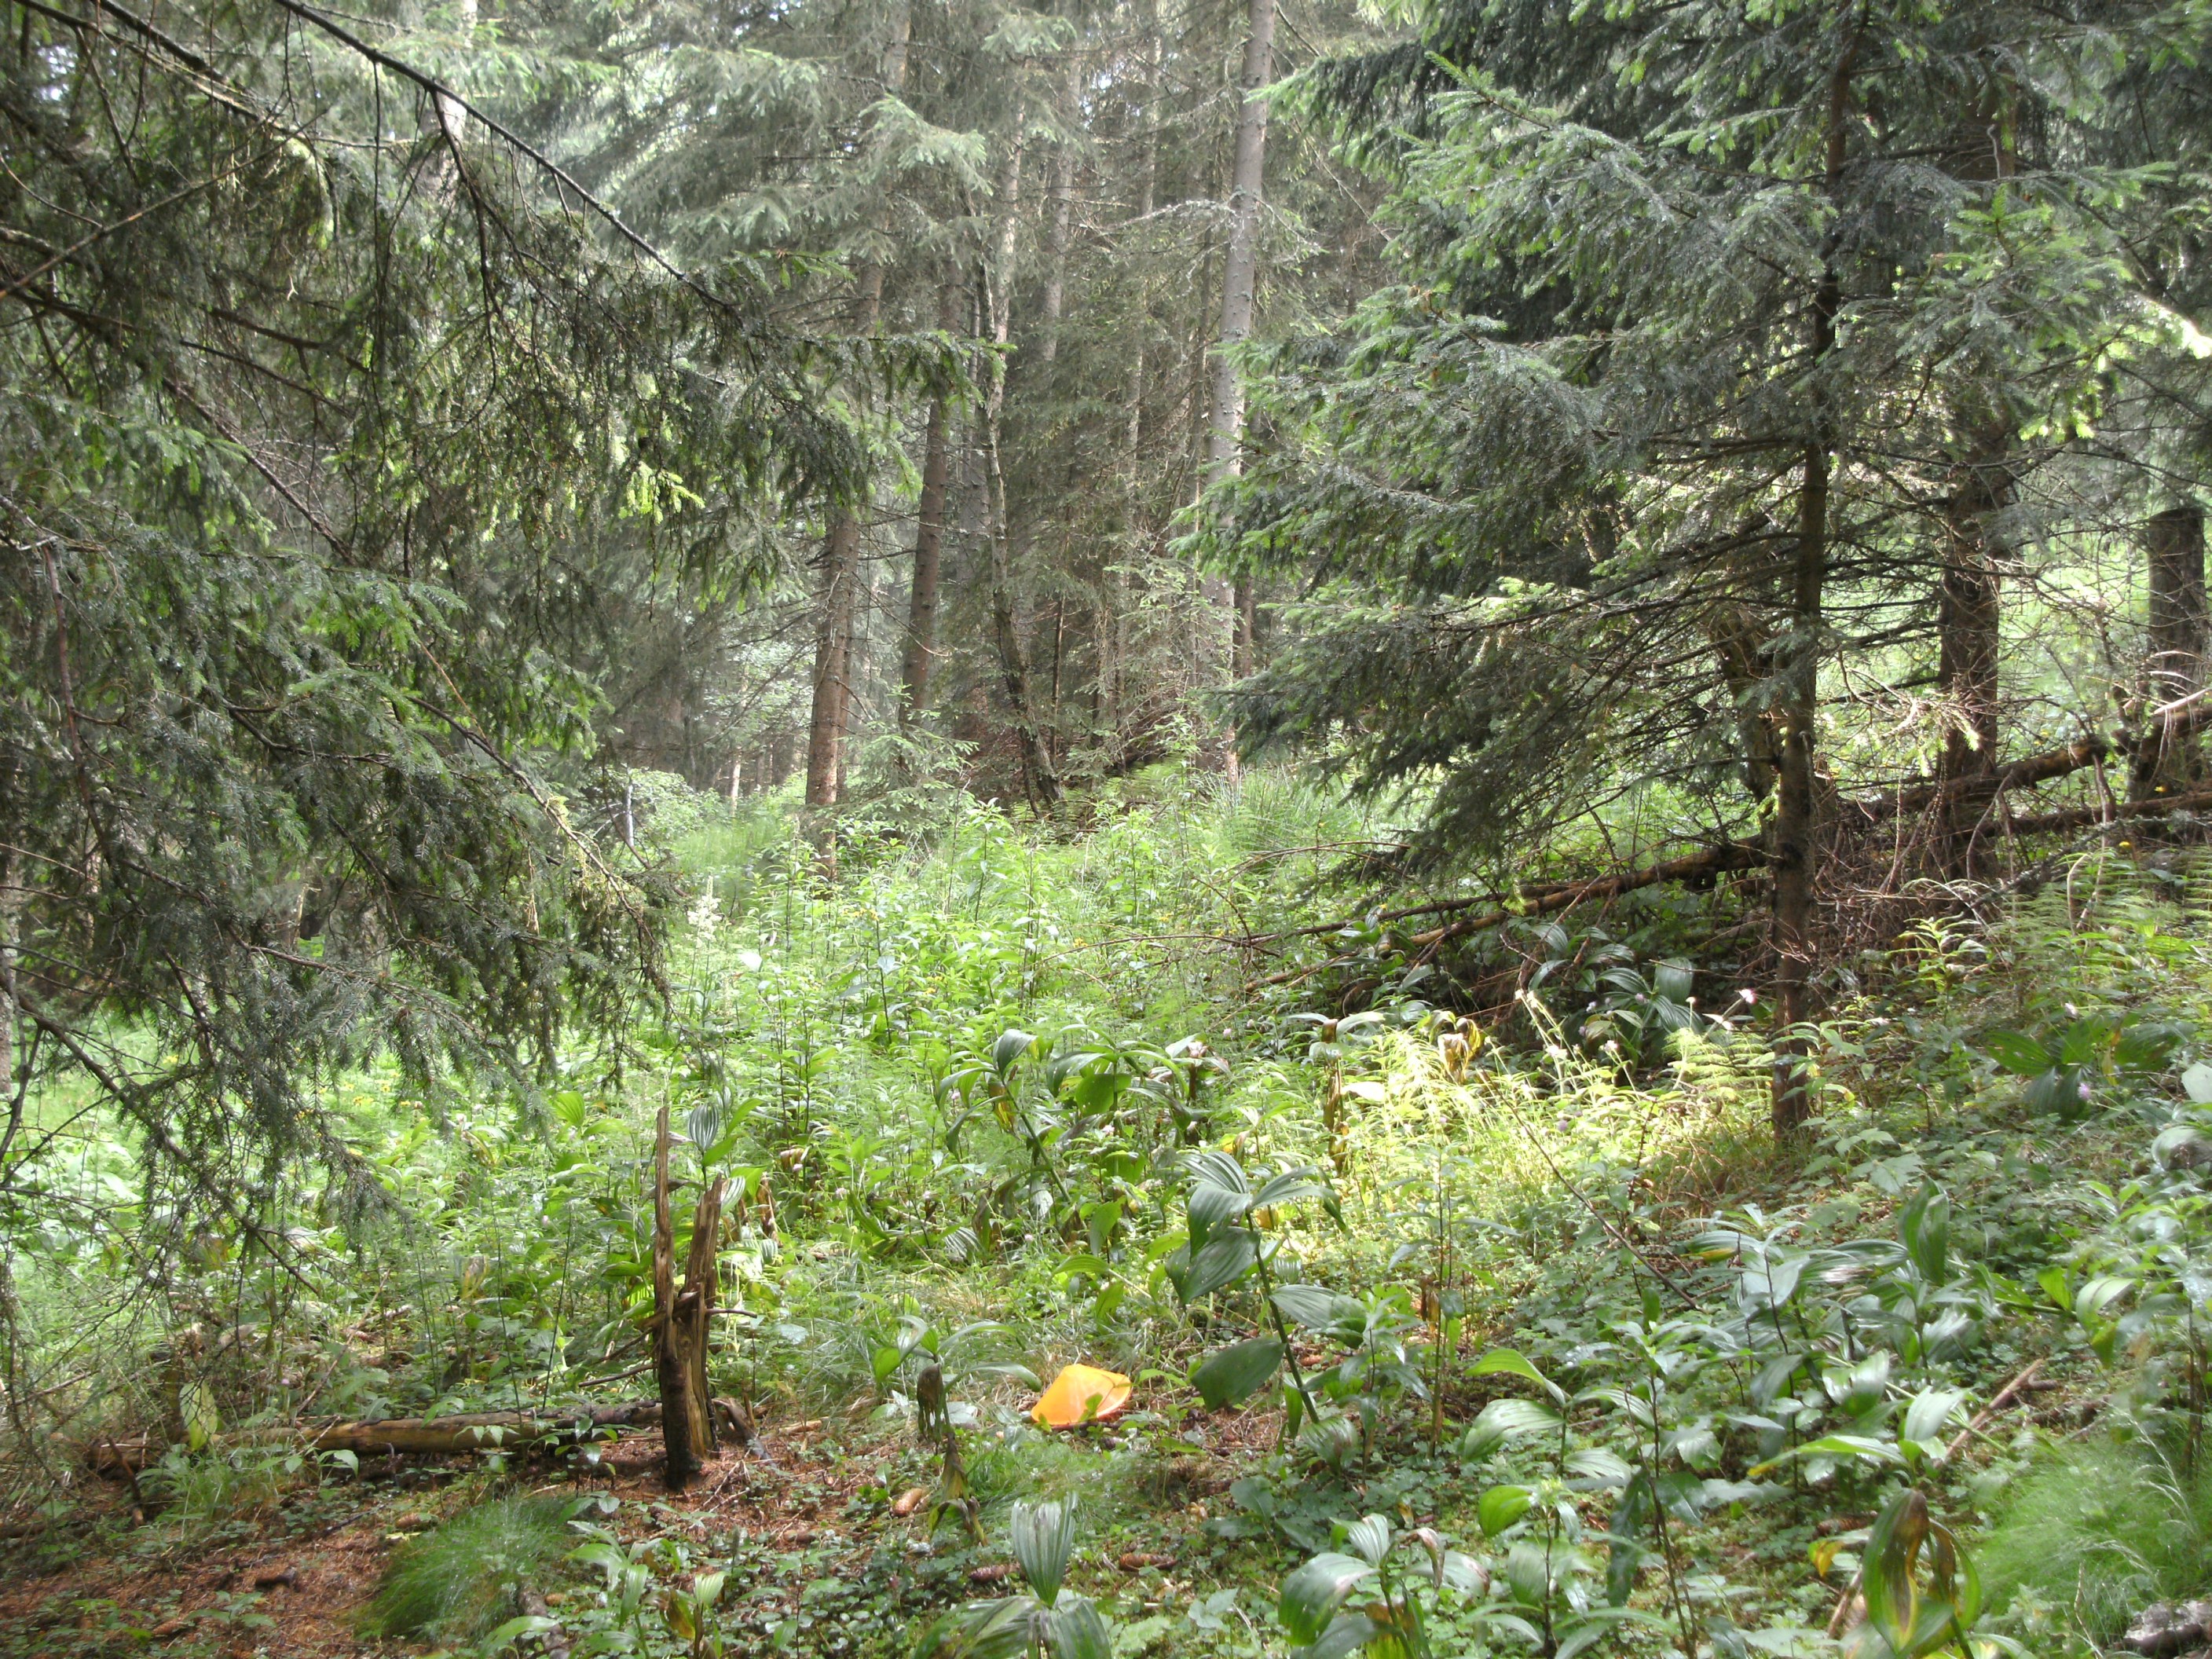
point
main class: Woodland
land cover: Spruce dominated coniferous woodland
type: alpine coniferous forest
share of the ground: 50 - 75 %
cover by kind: coniferous forest trees 60 %, herbaceous plants 30 %, unconsolidated bare surface 10 %
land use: Forestry
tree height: > 5 m
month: July
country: AT
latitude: 46.9316
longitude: 14.7400
